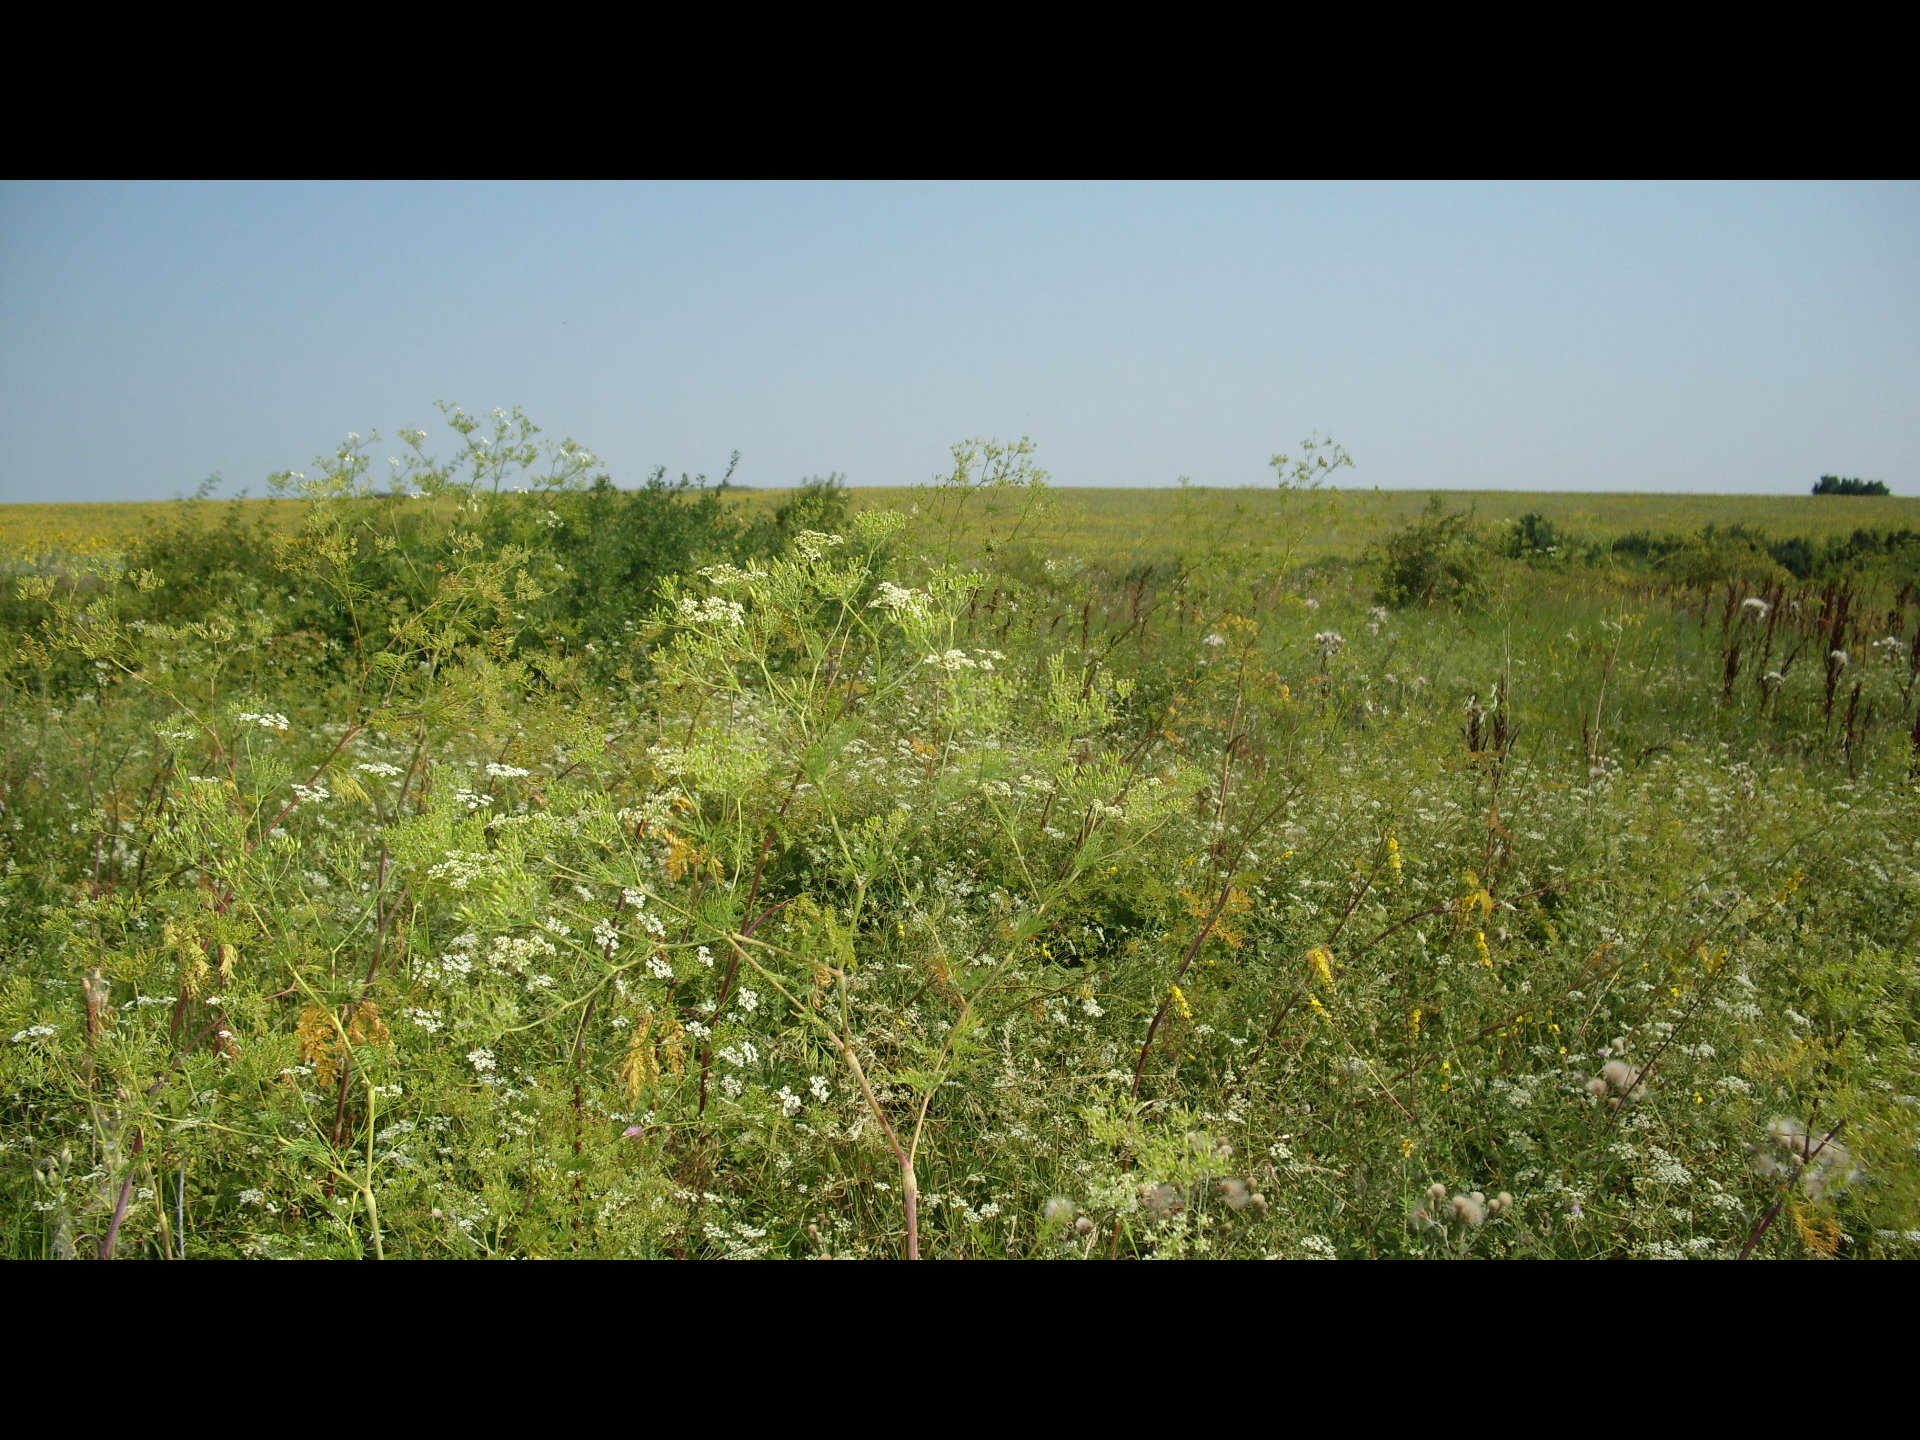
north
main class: Grassland
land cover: Grassland with sparse tree/shrub cover
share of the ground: > 75 %
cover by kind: herbaceous plants 85 %, shrubs 10 %, broadleaved forest trees 5 %
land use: Agriculture (excluding fallow land and kitchen gardens)
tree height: < 5 m
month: July
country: BG
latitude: 43.6433
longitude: 22.8170
